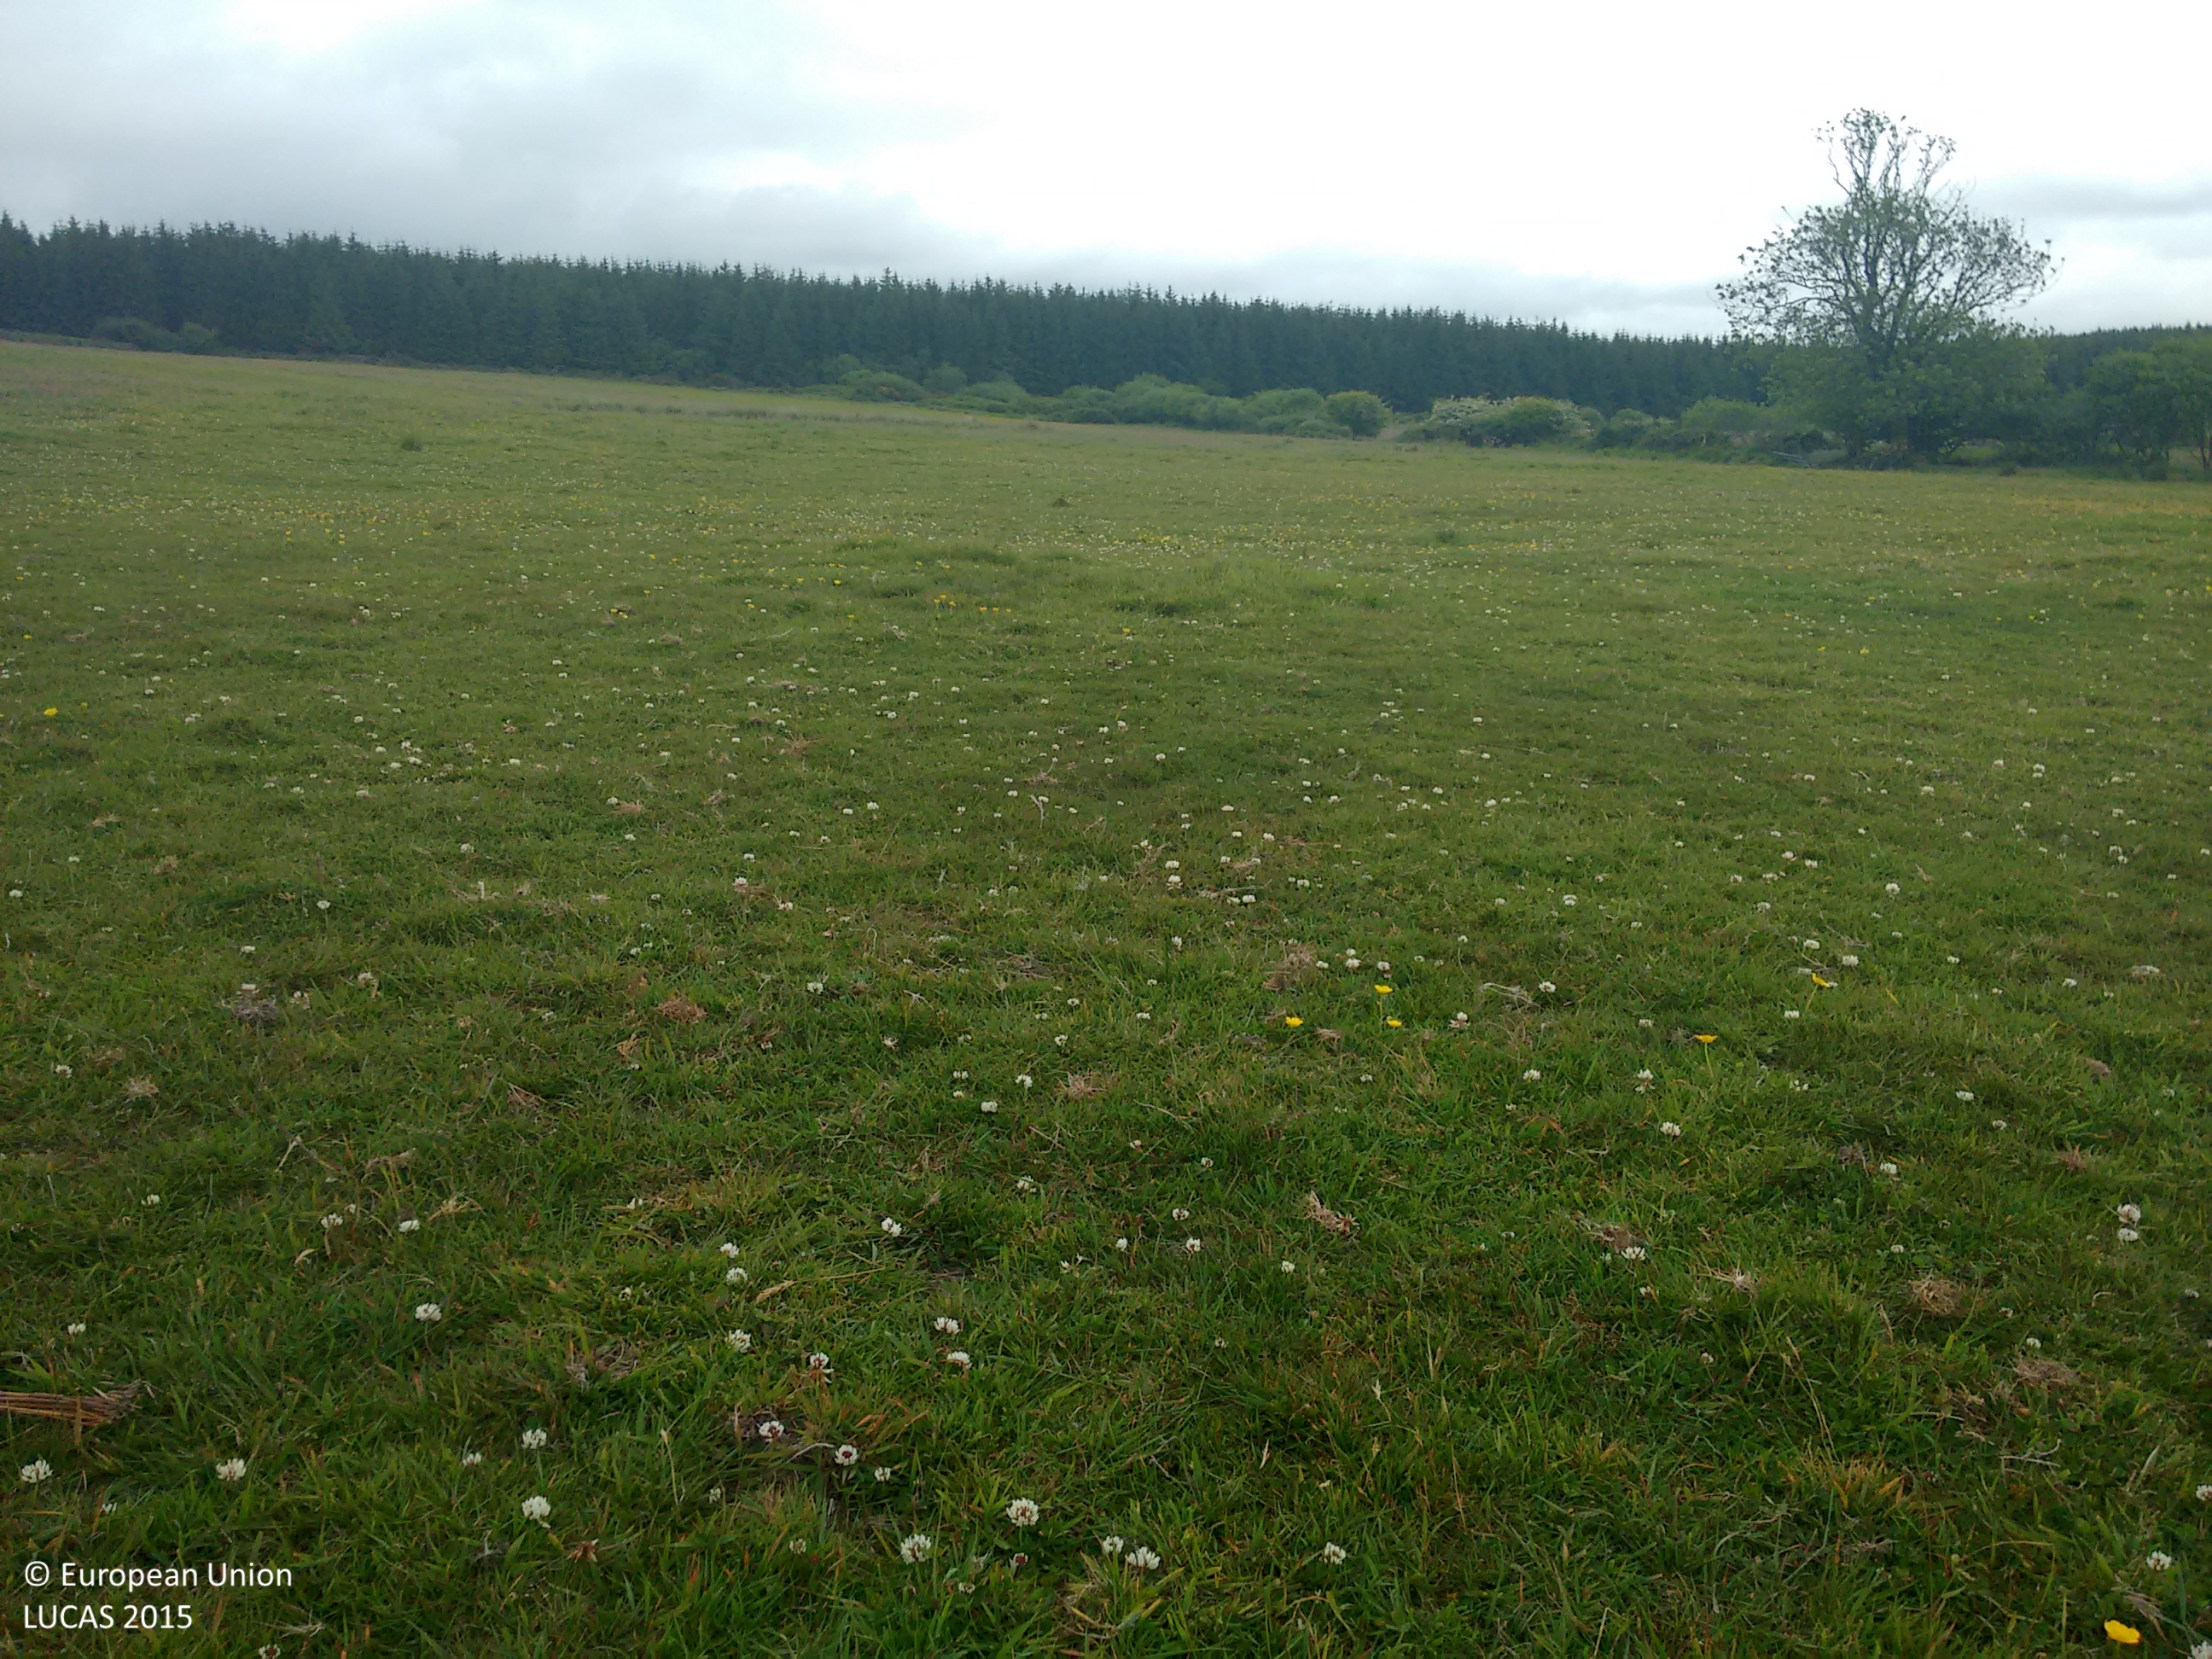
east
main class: Grassland
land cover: Grassland without tree/shrub cover
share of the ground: > 75 %
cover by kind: herbaceous plants 100 %
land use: Agriculture (excluding fallow land and kitchen gardens)
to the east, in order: Grassland without tree/shrub cover; Shrubland with sparse tree cover
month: June
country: IE
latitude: 52.0133
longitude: -8.1462
